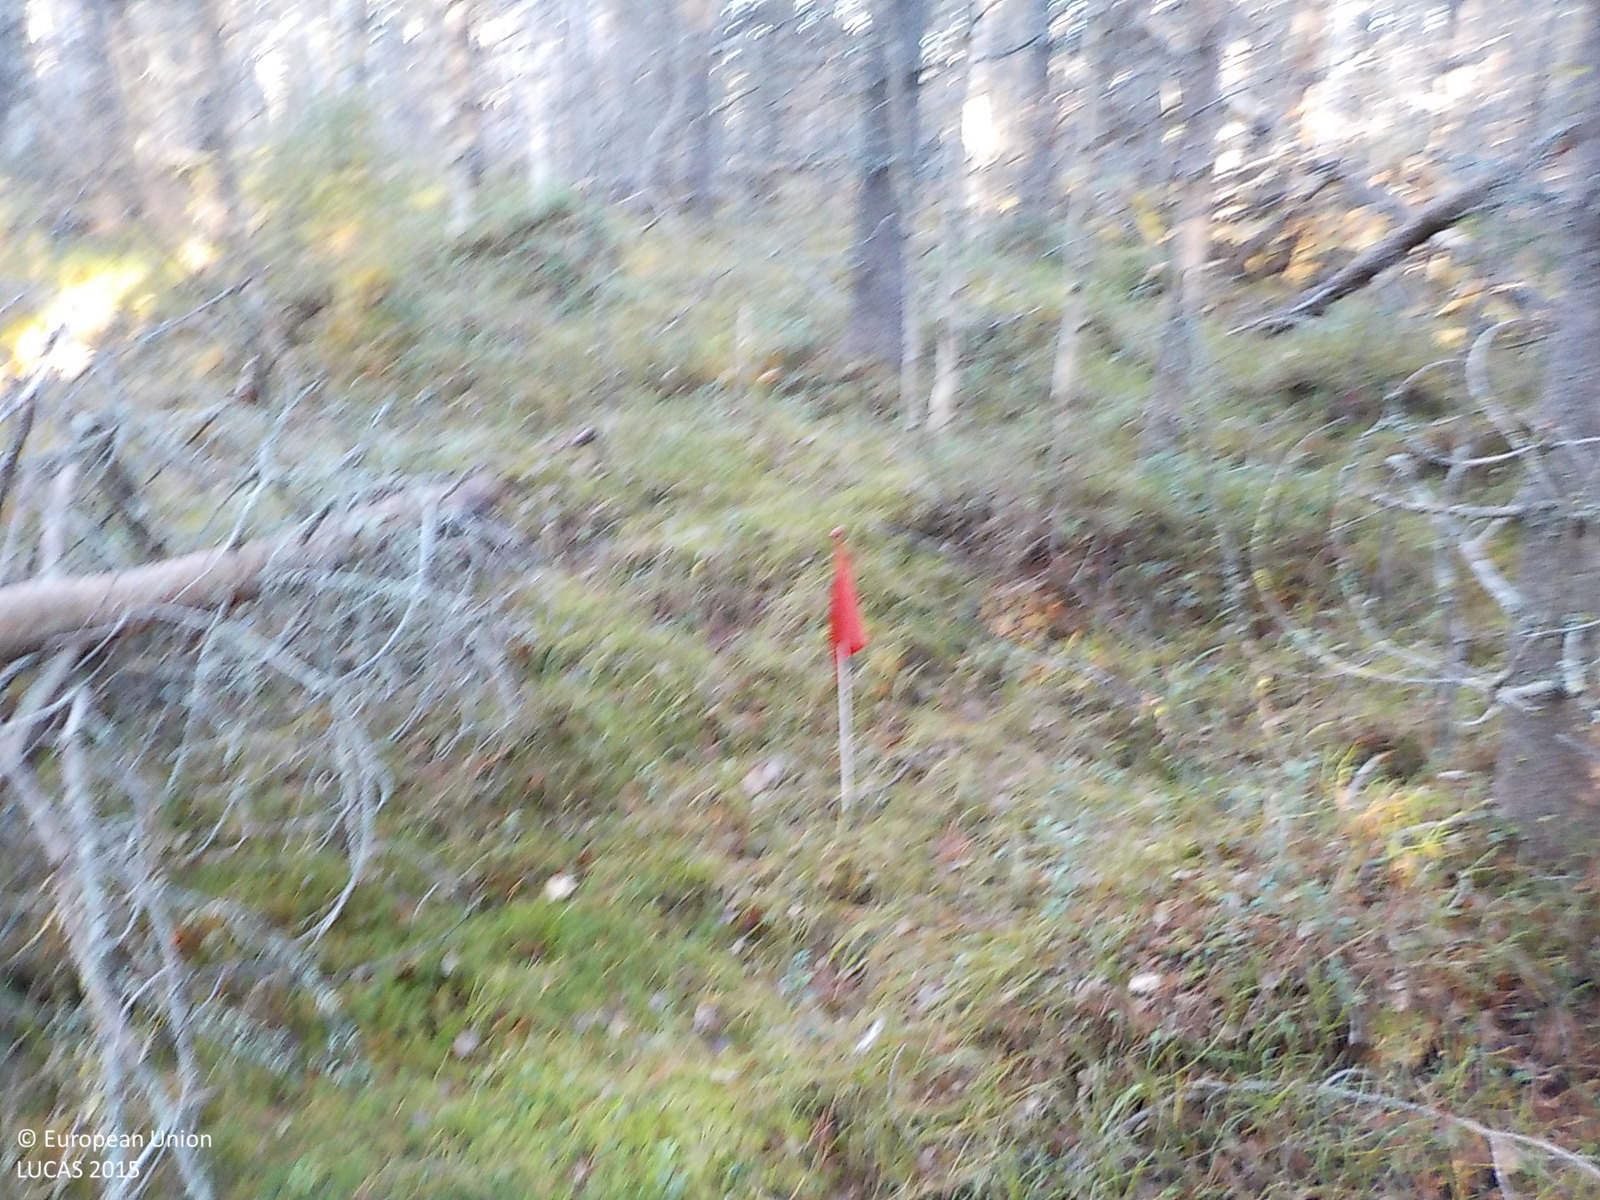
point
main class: Woodland
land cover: Pine dominated coniferous woodland
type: exotic forest
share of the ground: > 75 %
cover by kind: coniferous forest trees 80 %, shrubs 20 %
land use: Forestry
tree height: > 5 m
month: November
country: SE
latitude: 63.2330
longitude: 16.4834
